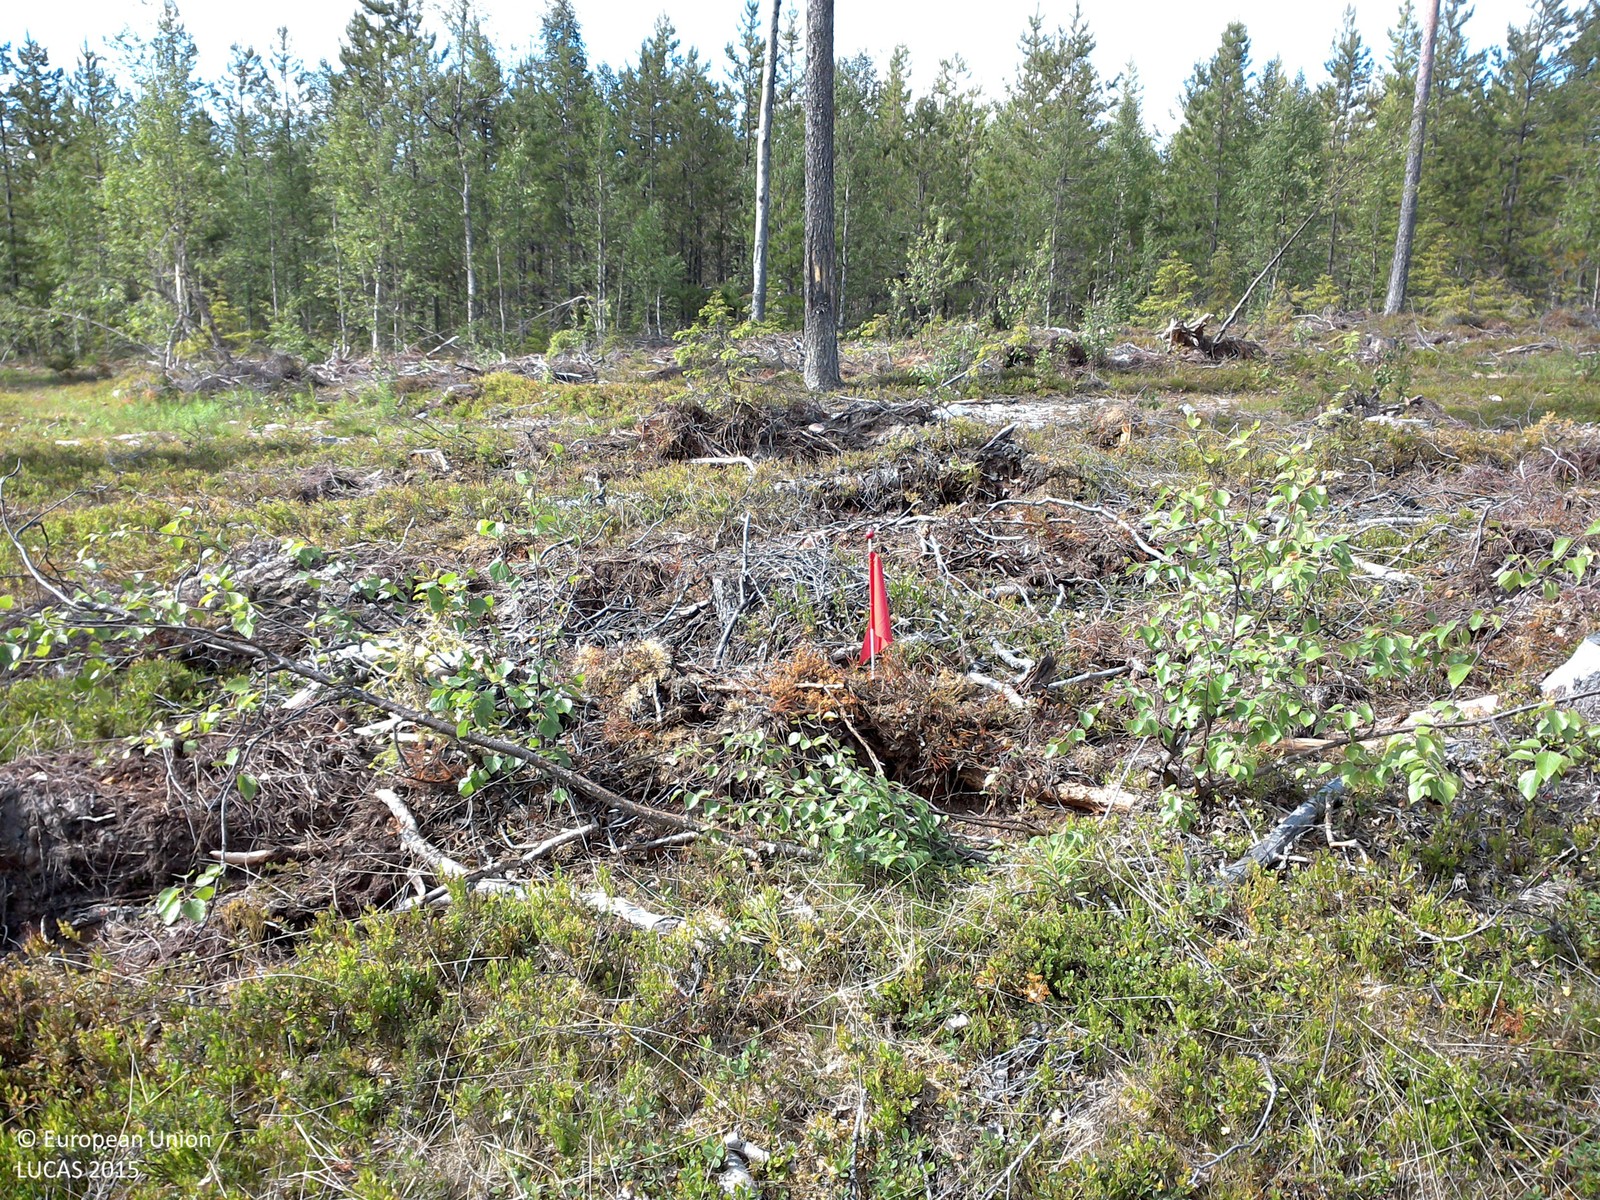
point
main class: Woodland
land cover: Pine dominated mixed woodland
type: boreal forest
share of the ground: 10 - 25 %
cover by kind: unconsolidated bare surface 50 %, shrubs 35 %, coniferous forest trees 10 %, broadleaved forest trees 5 %
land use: Forestry
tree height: > 5 m
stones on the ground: < 10 %
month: July
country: SE
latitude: 67.0349
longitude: 23.0854
